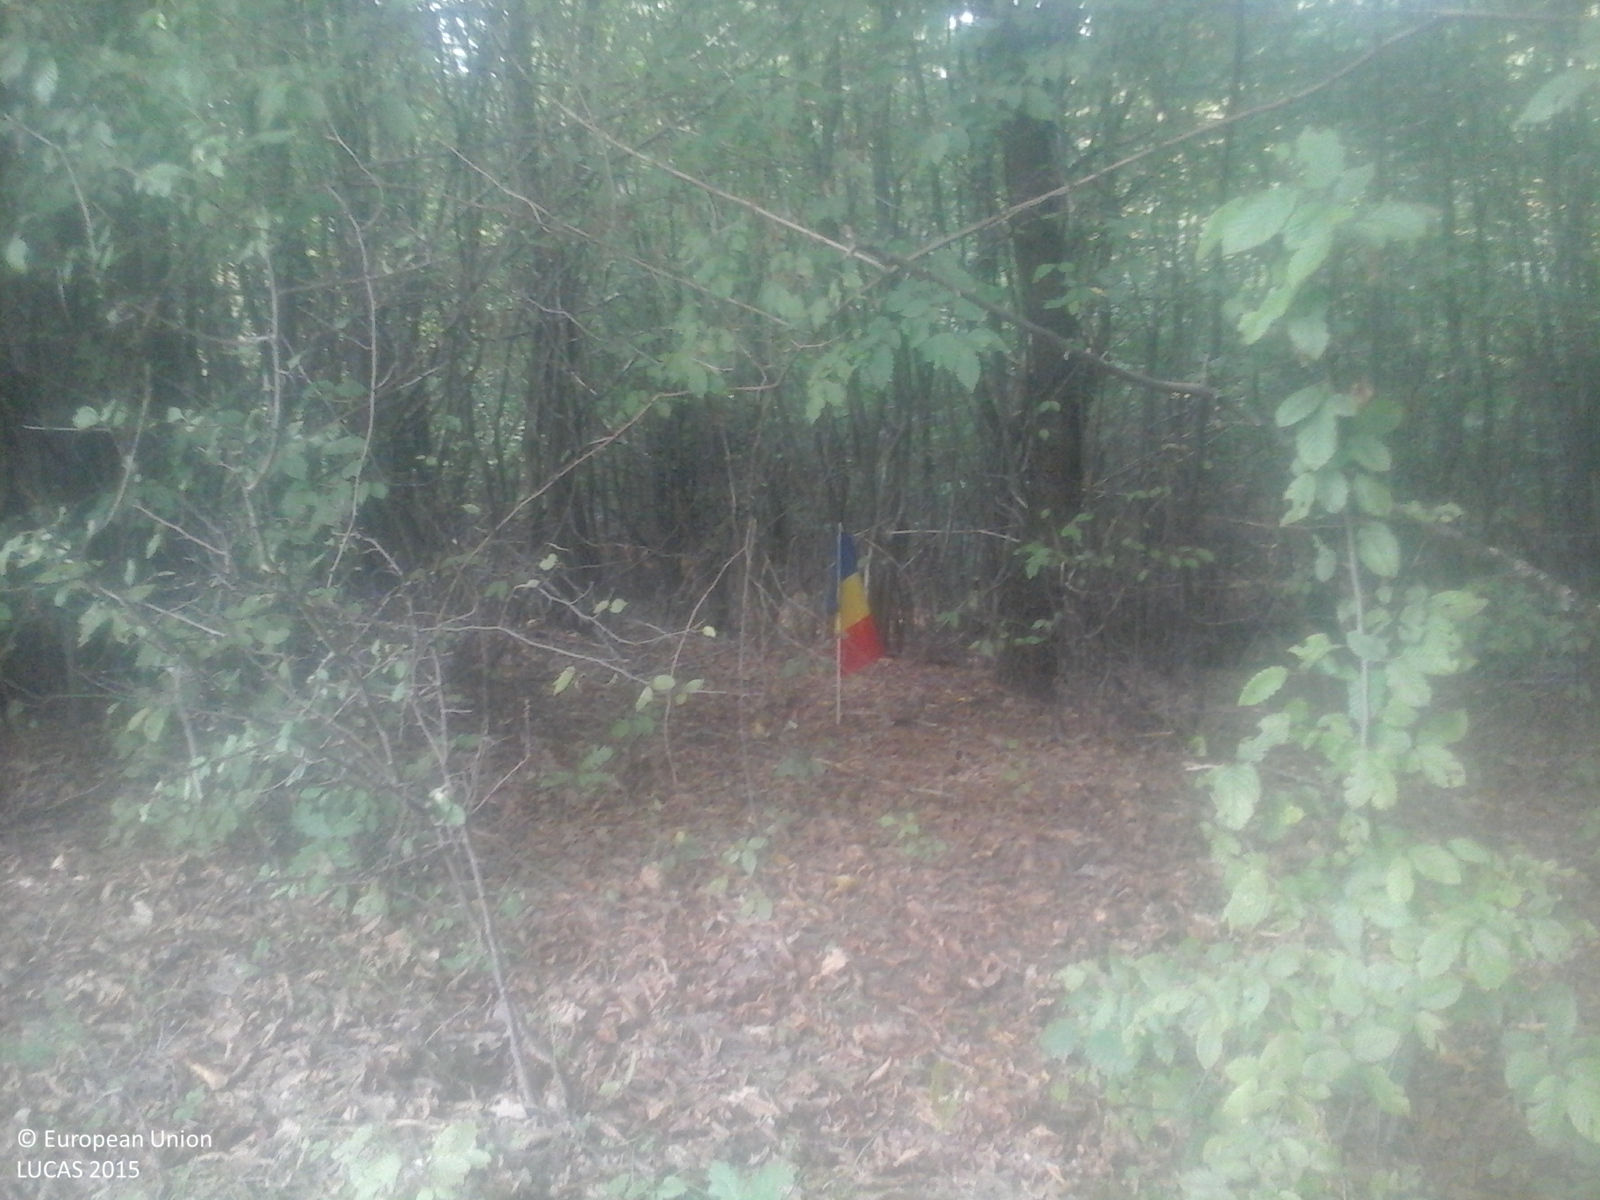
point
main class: Woodland
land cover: Broadleaved woodland
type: beech forest
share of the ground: > 75 %
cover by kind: broadleaved forest trees 100 %
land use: Forestry
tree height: > 5 m
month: September
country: RO
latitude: 47.1389
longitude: 23.1587
